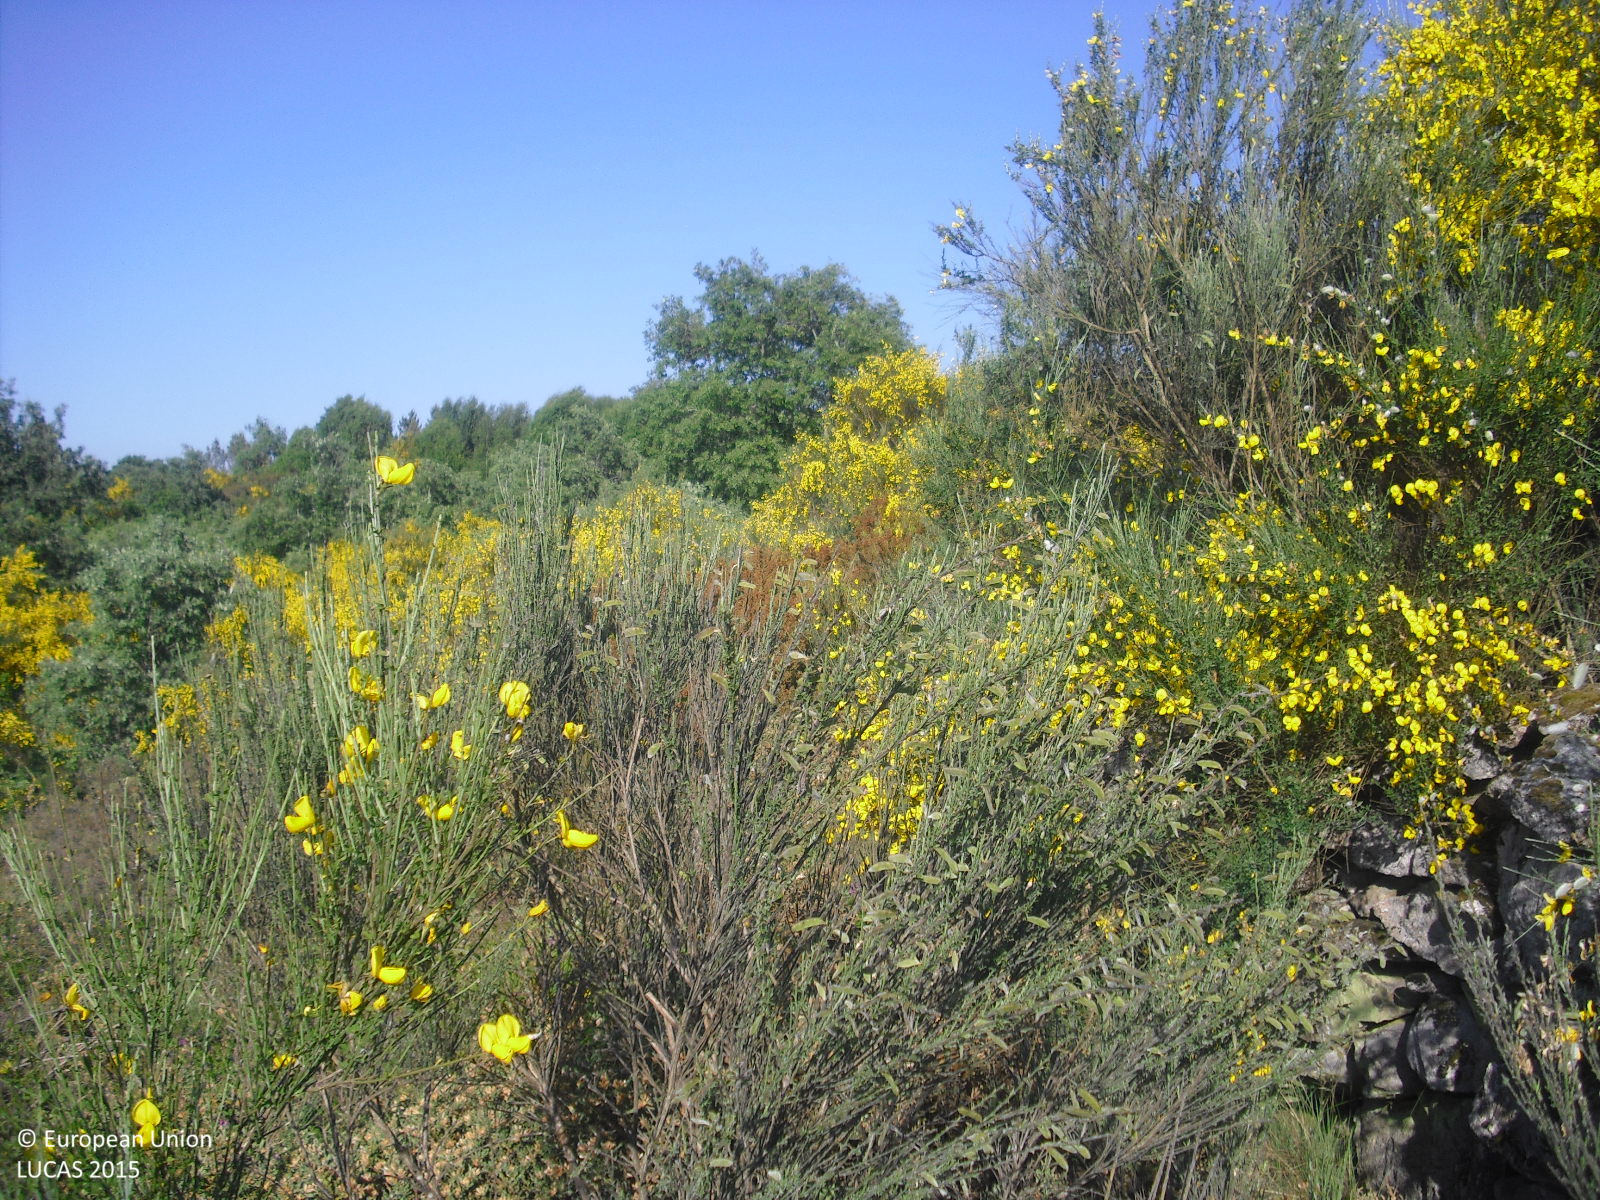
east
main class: Shrubland
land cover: Shrubland without tree cover
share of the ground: > 75 %
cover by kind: shrubs 100 %
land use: Semi-natural and natural areas not in use
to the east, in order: Shrubland without tree cover; Dry stone walls; Shrubland without tree cover; Tracks; Shruby margins; Dry stone walls; Shrubland with sparse tree cover; Broadleaved woodland; Dry stone walls; Broadleaved woodland; Shrubland without tree cover; Dry stone walls; Shrubland without tree cover; Dry stone walls; Shrubland without tree cover; Dry stone walls; Shrubland without tree cover
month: May
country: ES
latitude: 42.2242
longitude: -7.6988
